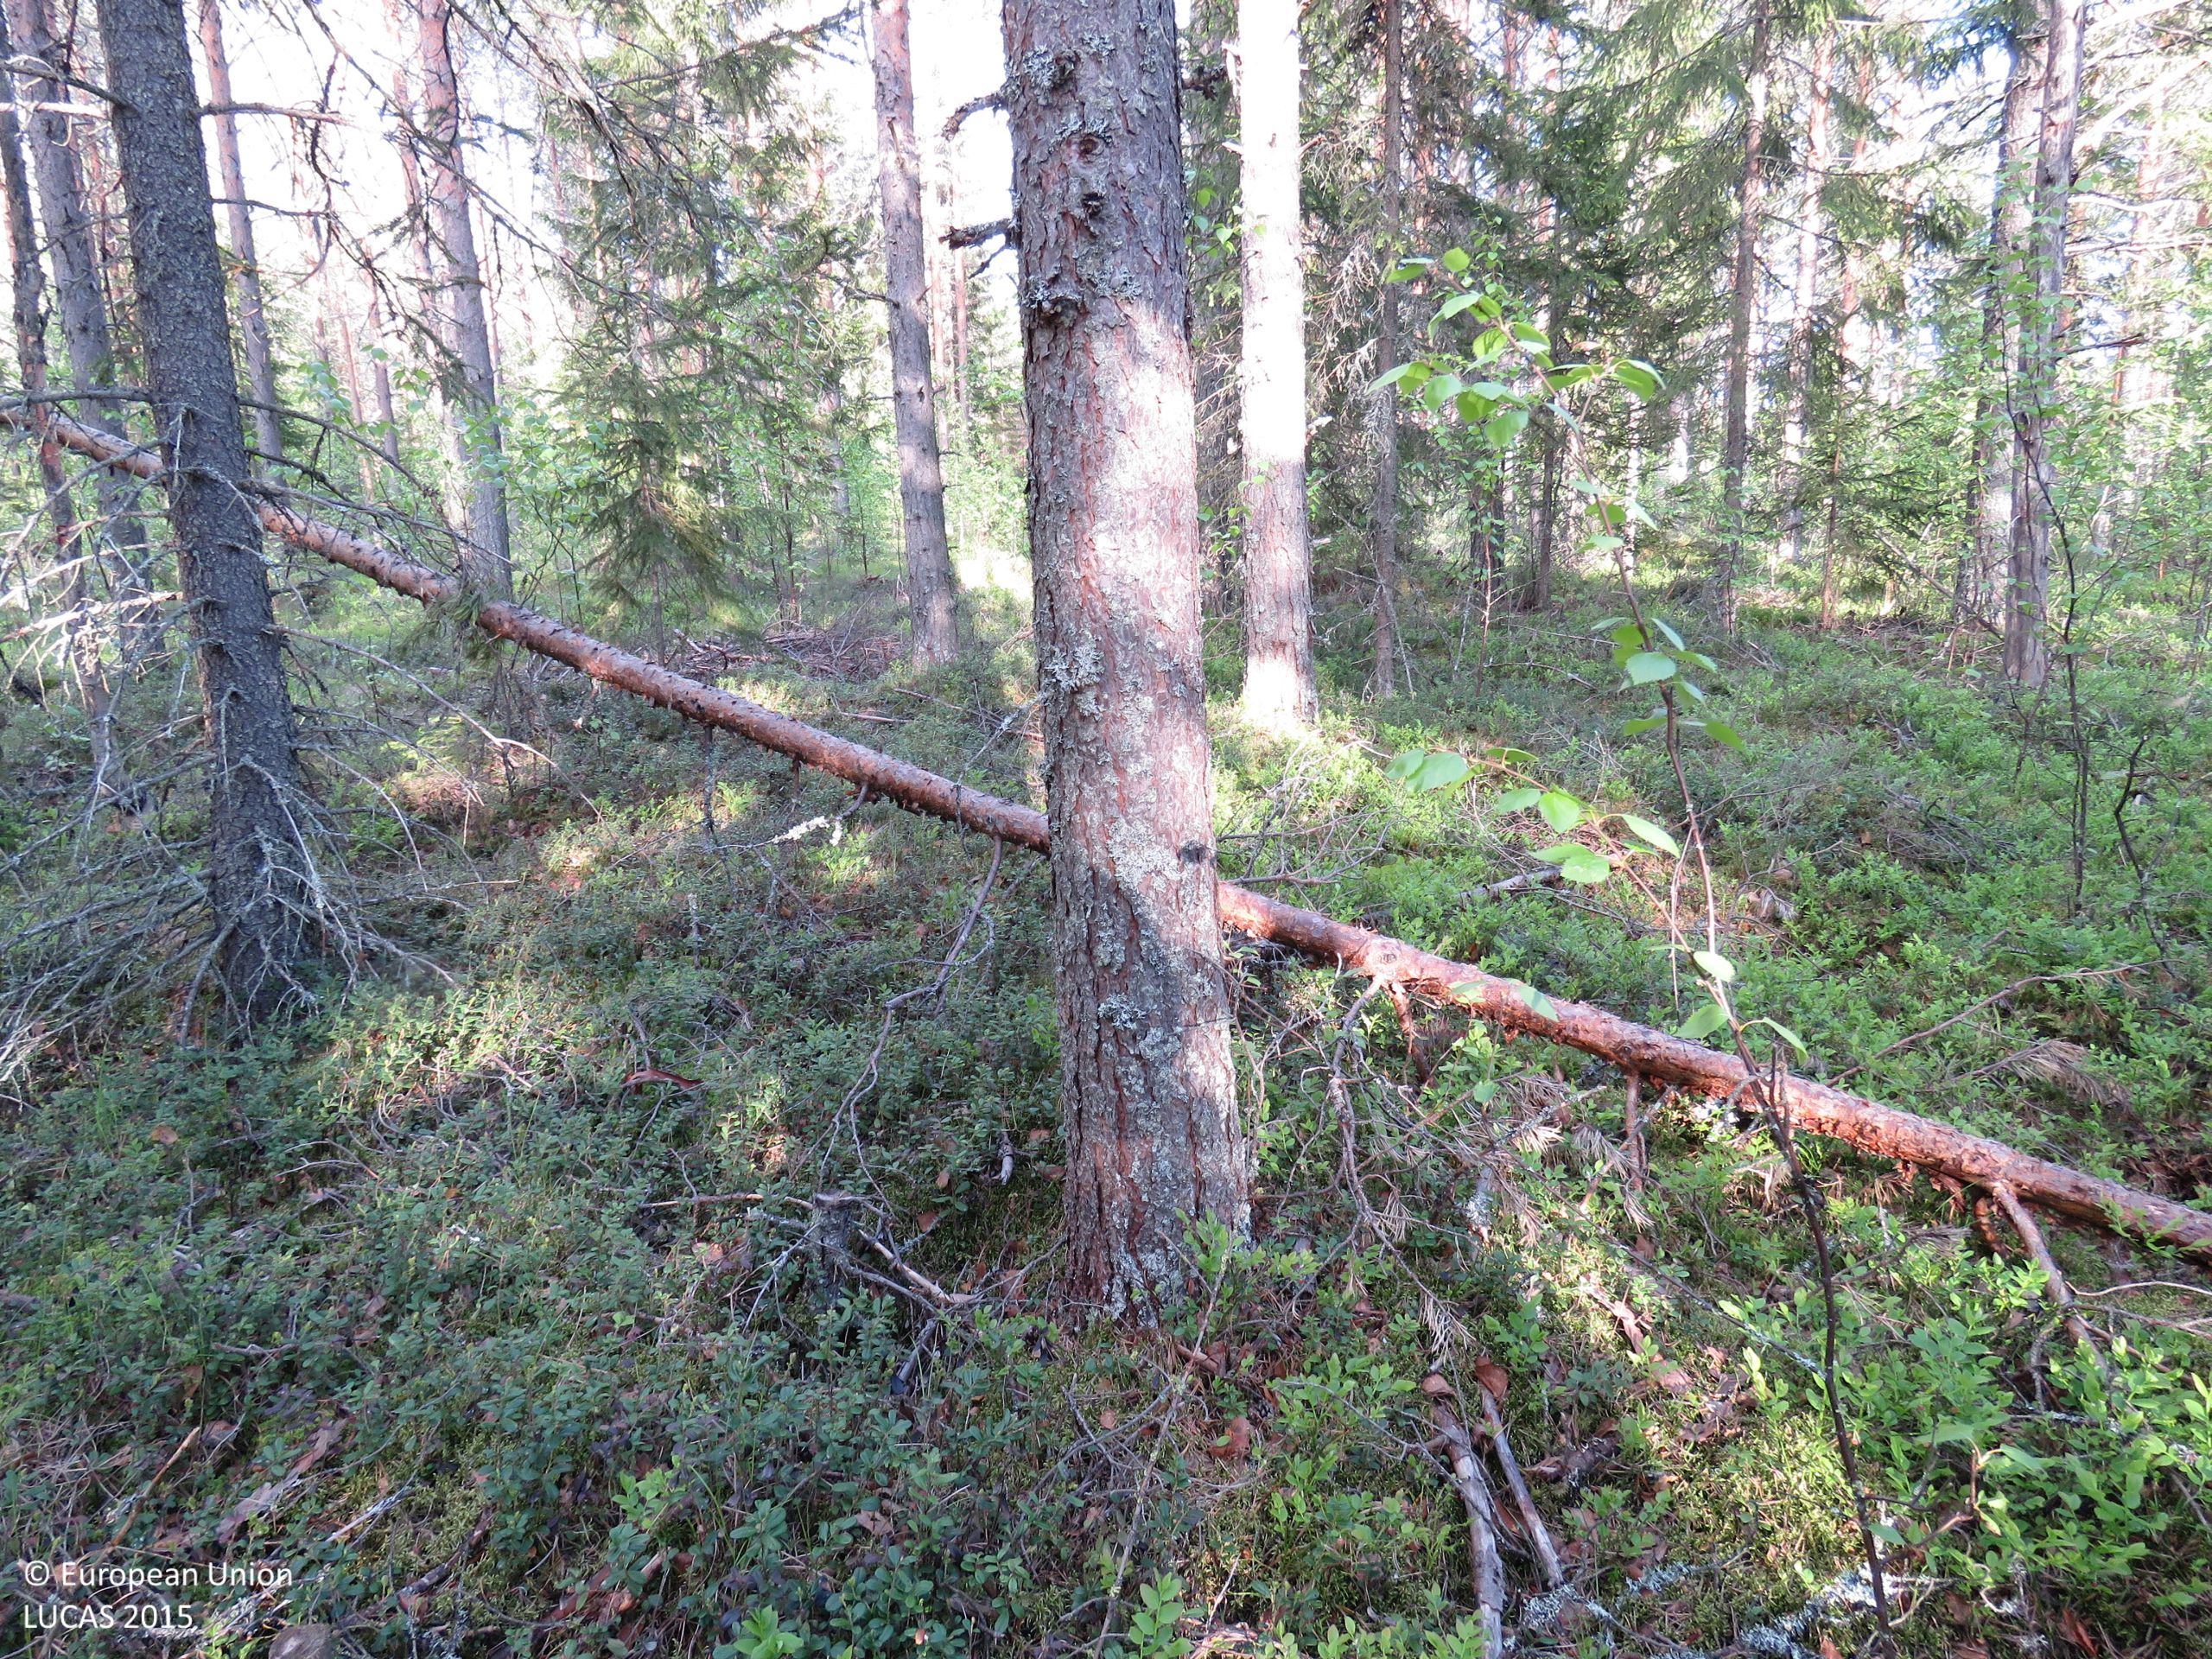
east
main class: Woodland
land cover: Other coniferous woodland
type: boreal forest
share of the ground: 50 - 75 %
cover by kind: coniferous forest trees 55 %, shrubs 25 %, broadleaved forest trees 15 %, lichens and mosses 5 %
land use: Forestry
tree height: > 5 m
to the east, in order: Other coniferous woodland; Tracks; Other coniferous woodland; Pine dominated coniferous woodland; Tracks; Pine dominated coniferous woodland; Shrubland without tree cover; Pine dominated coniferous woodland
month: June
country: FI
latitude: 65.1545
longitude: 25.9838
